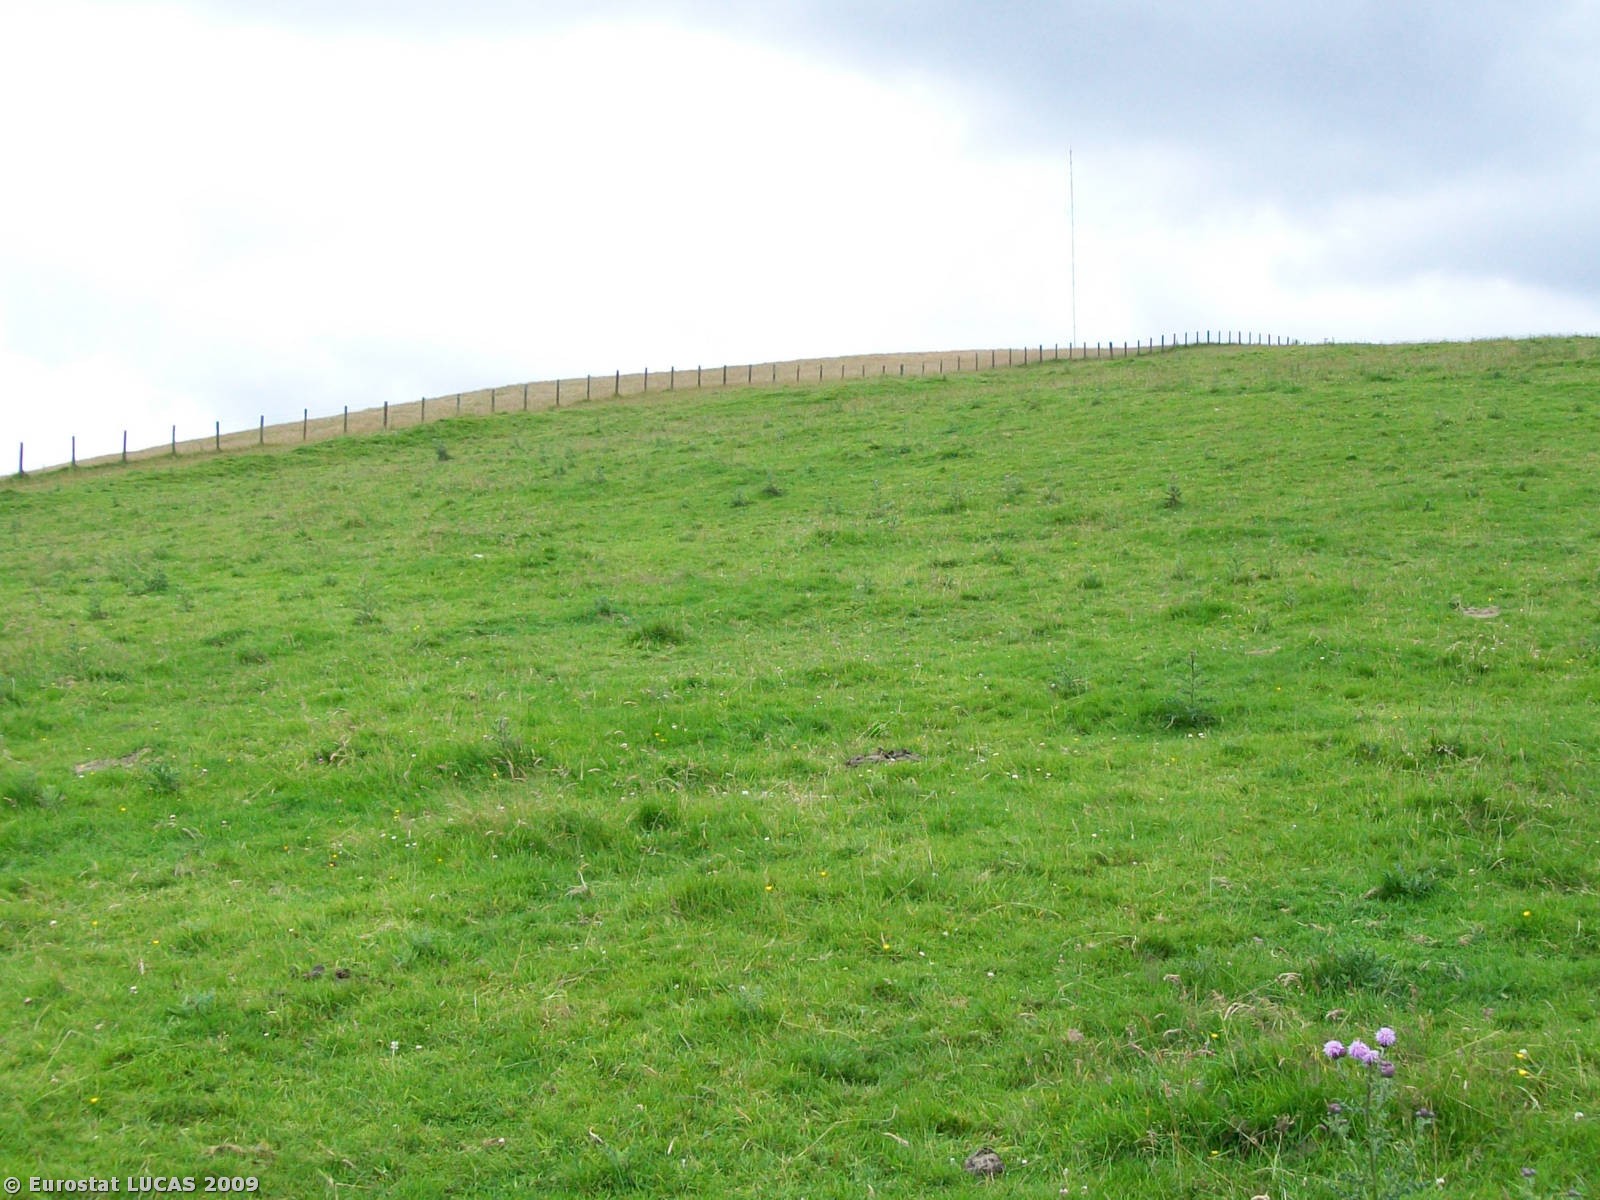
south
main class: Grassland
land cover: Grassland without tree/shrub cover
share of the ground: > 75 %
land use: Agriculture (excluding fallow land and kitchen gardens)
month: July
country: GB
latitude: 55.1619
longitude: -3.3085
